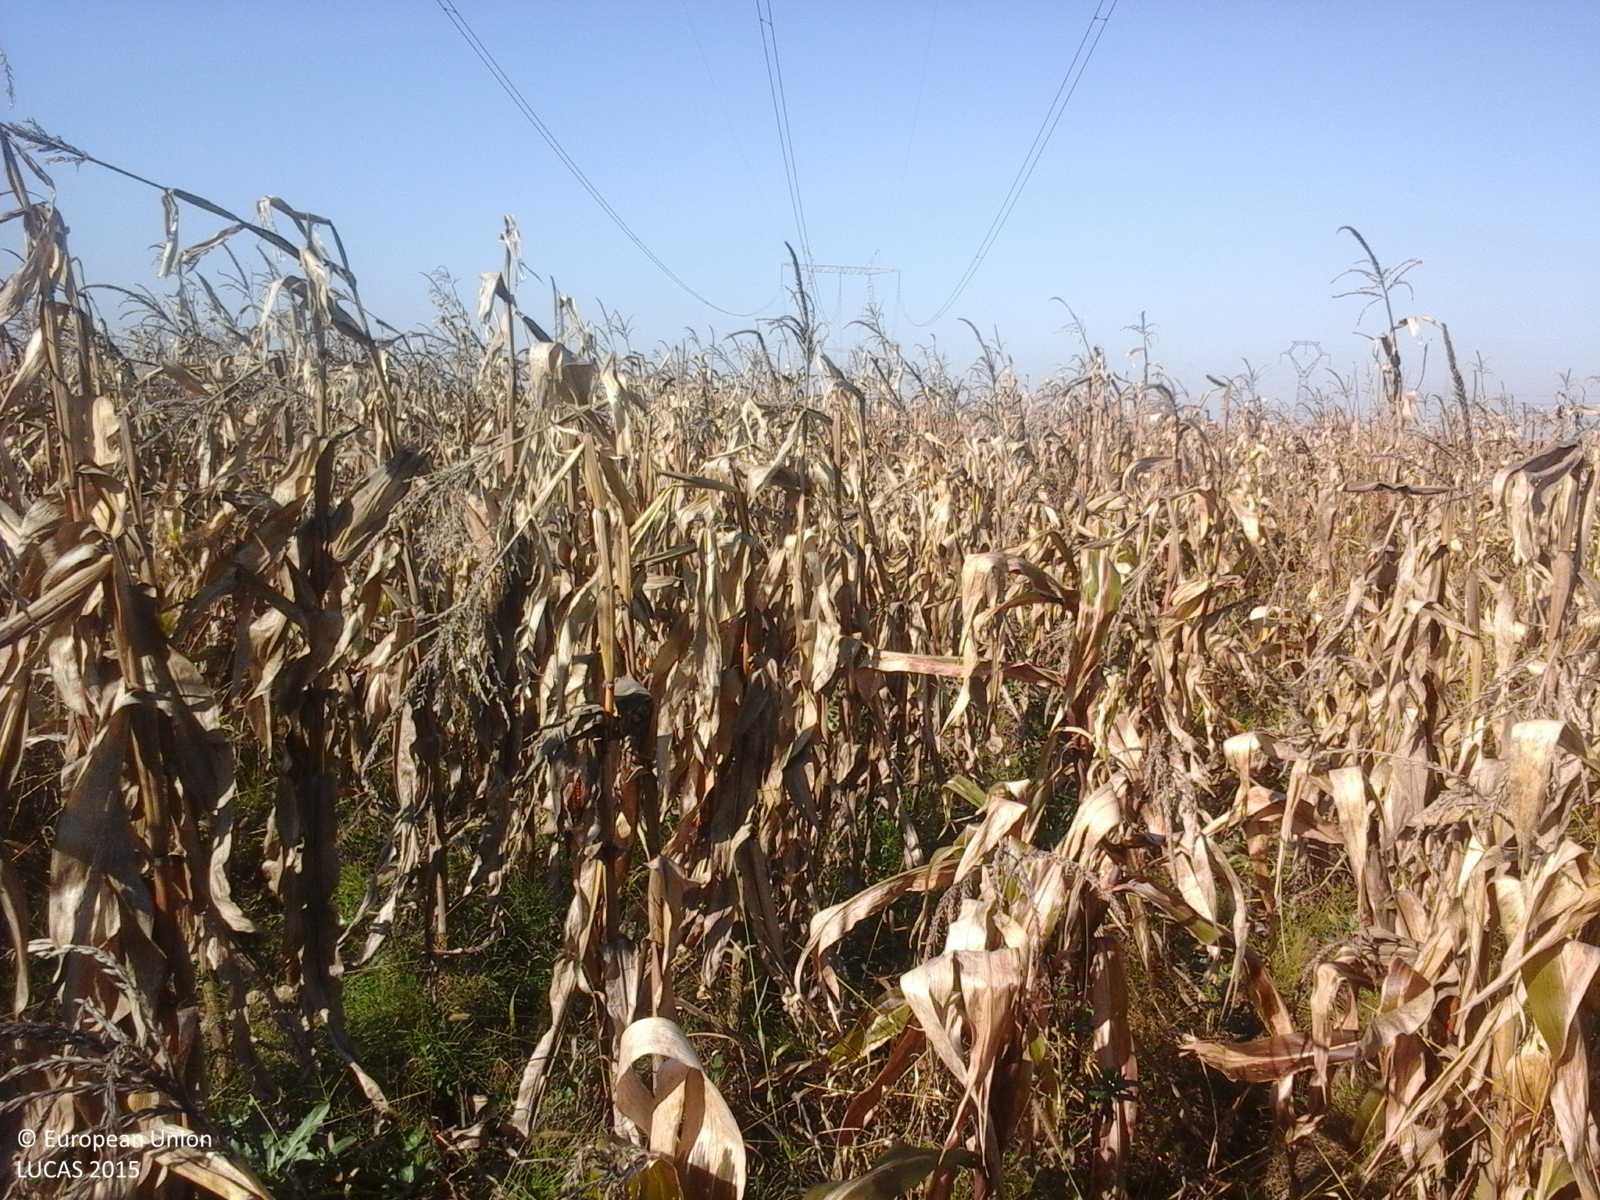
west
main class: Cropland
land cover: Maize
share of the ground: > 75 %
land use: Agriculture (excluding fallow land and kitchen gardens)
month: October
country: RO
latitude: 45.6456
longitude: 27.4096
